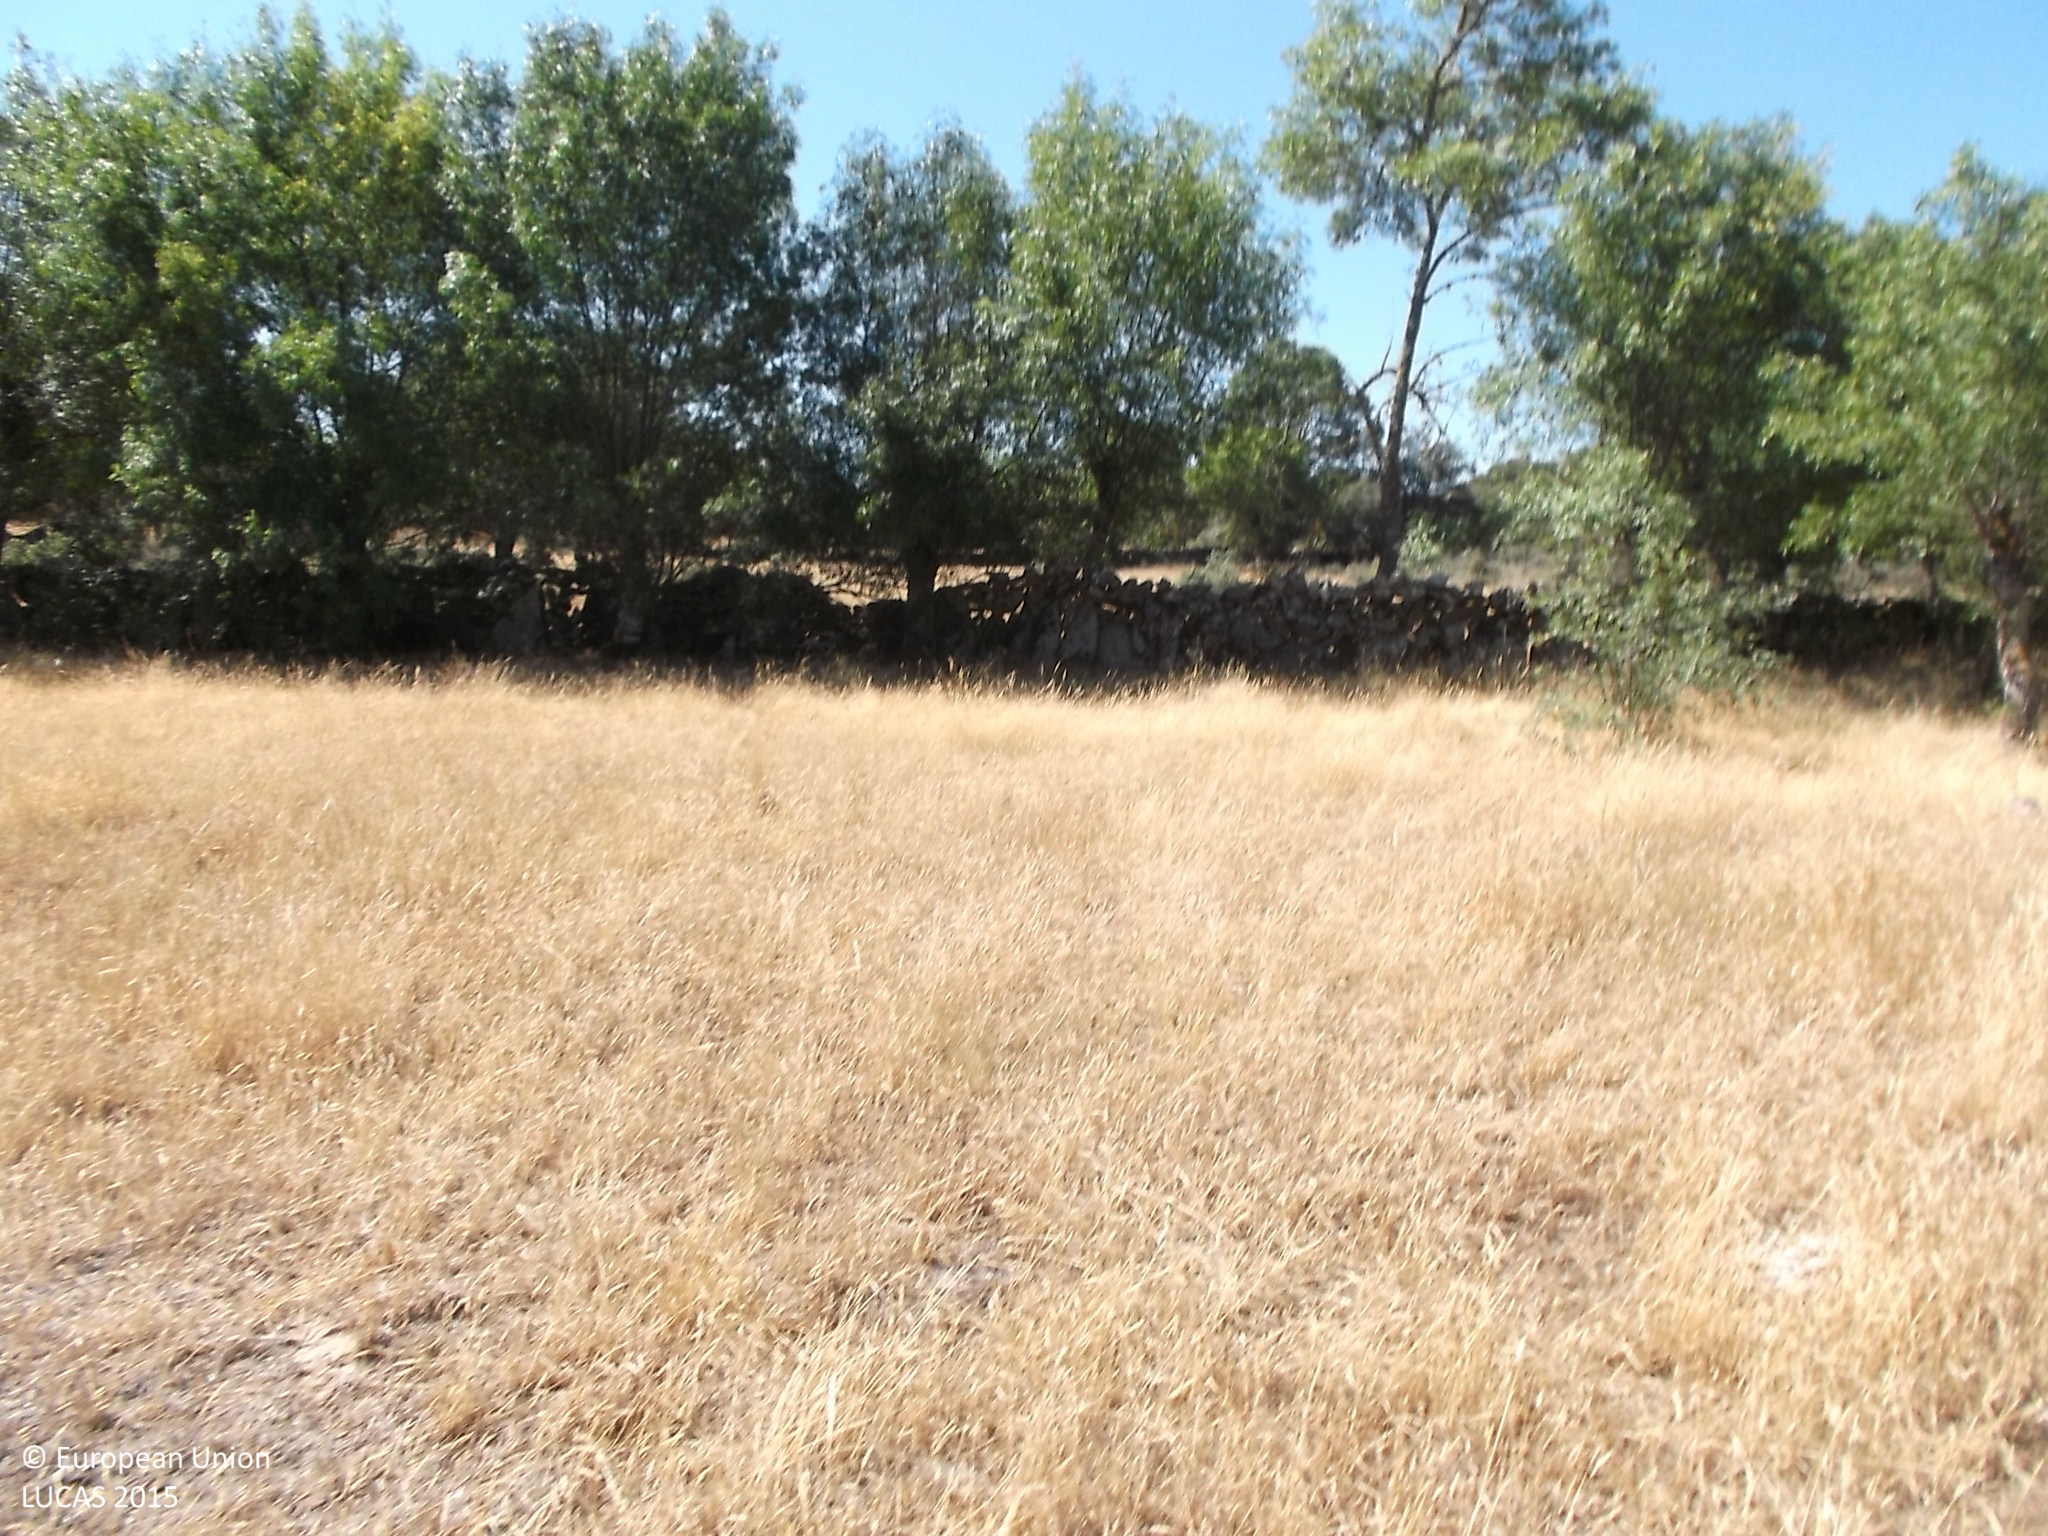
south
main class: Grassland
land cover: Grassland with sparse tree/shrub cover
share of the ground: > 75 %
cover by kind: herbaceous plants 90 %, broadleaved forest trees 5 %, shrubs 5 %
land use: Agriculture (excluding fallow land and kitchen gardens)
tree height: < 5 m
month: June
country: ES
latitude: 40.8972
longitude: -6.7531
